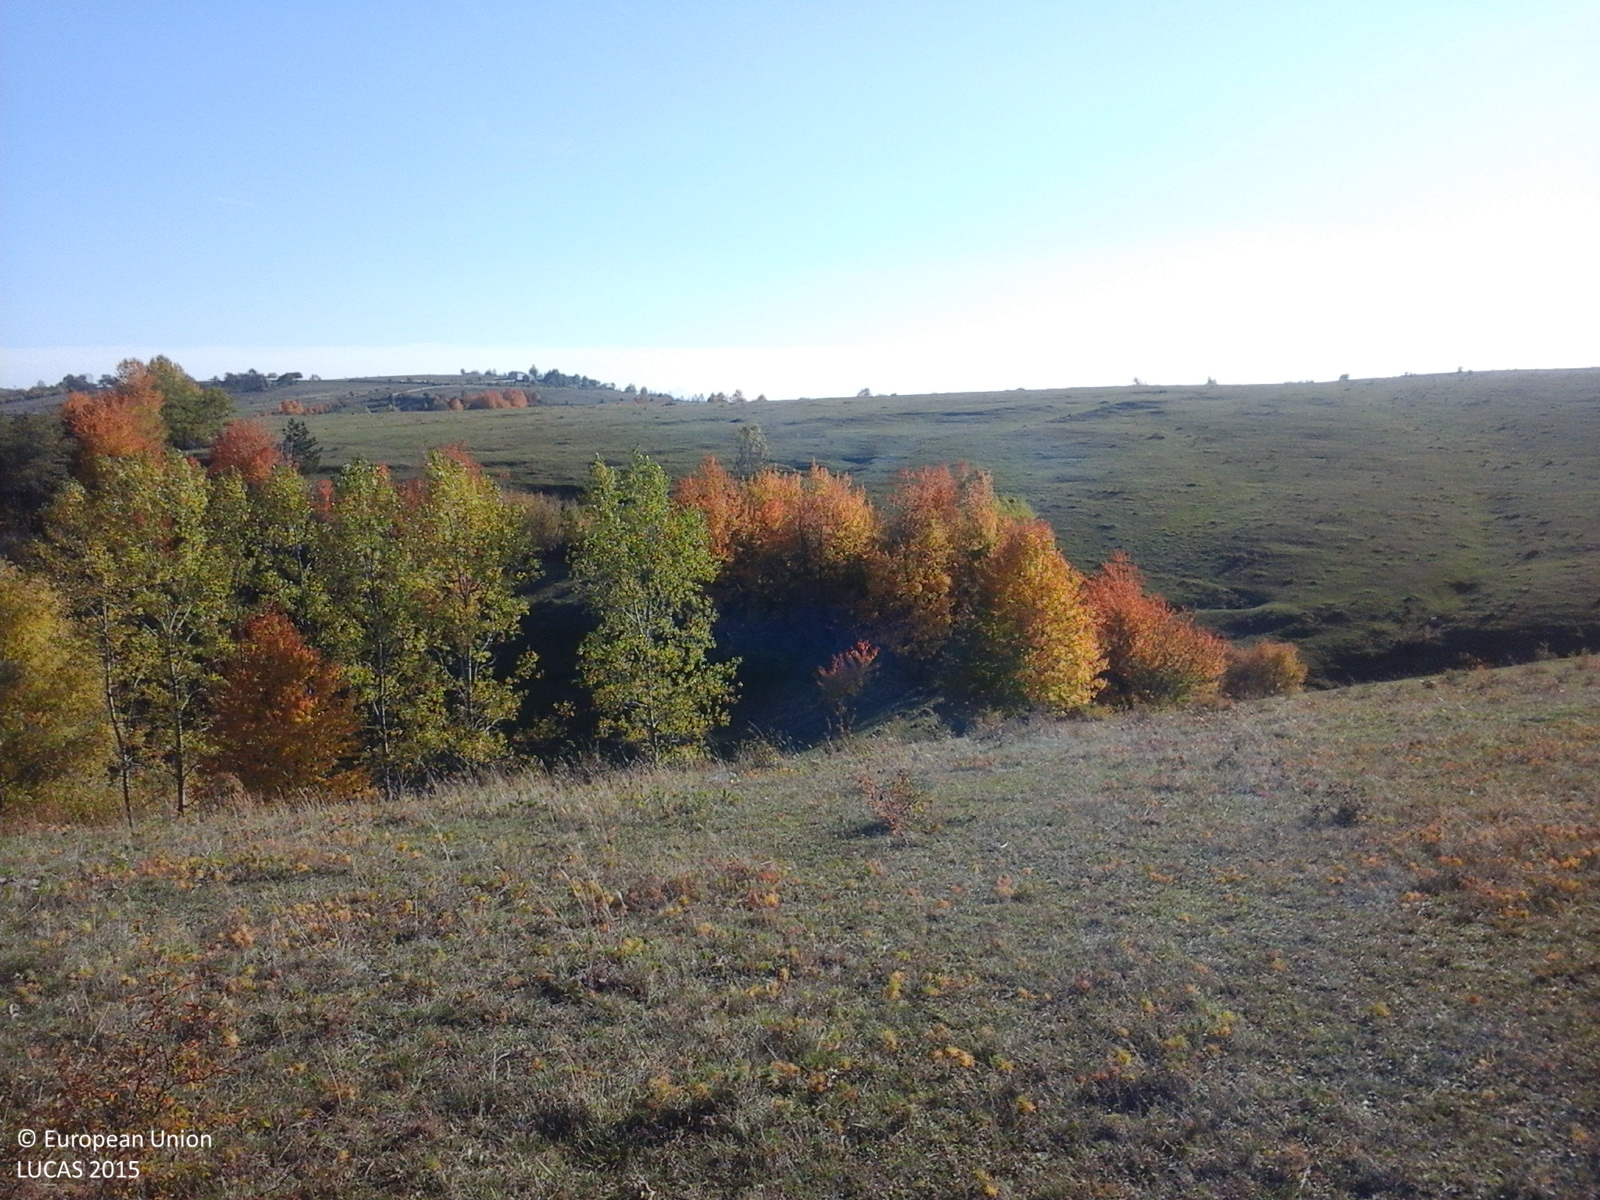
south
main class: Grassland
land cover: Grassland without tree/shrub cover
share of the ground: > 75 %
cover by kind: herbaceous plants 100 %
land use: Agriculture (excluding fallow land and kitchen gardens)
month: October
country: RO
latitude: 45.9046
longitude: 26.7250
